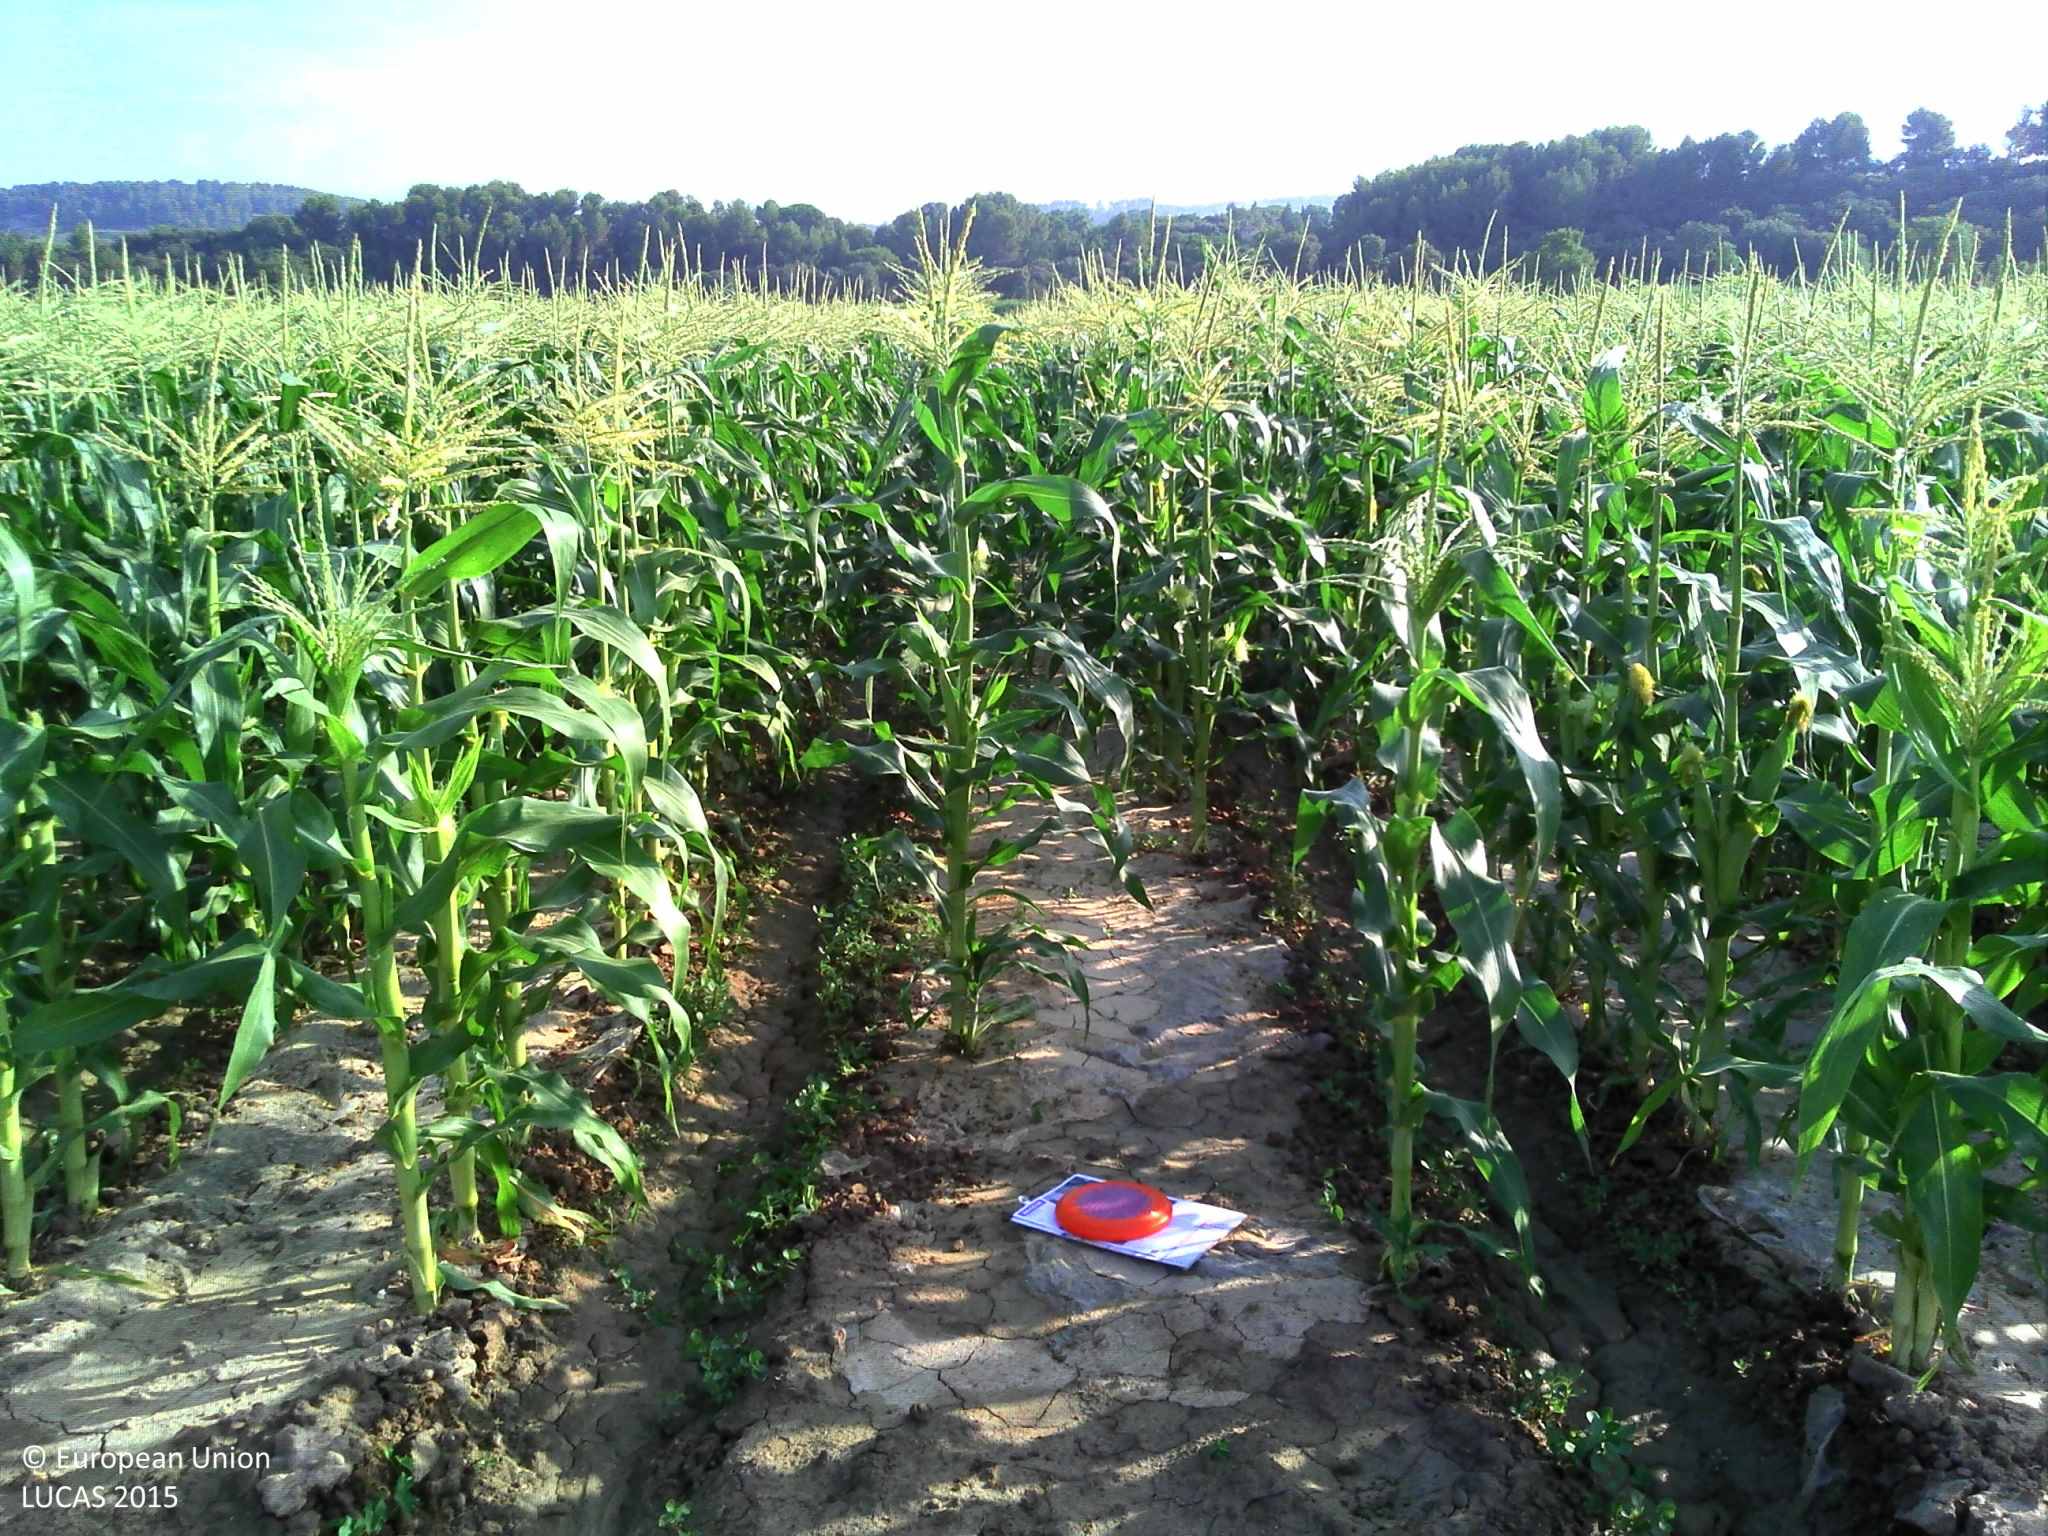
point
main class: Cropland
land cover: Maize
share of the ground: > 75 %
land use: Agriculture (excluding fallow land and kitchen gardens)
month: July
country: FR
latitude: 43.6762
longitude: 5.5315
